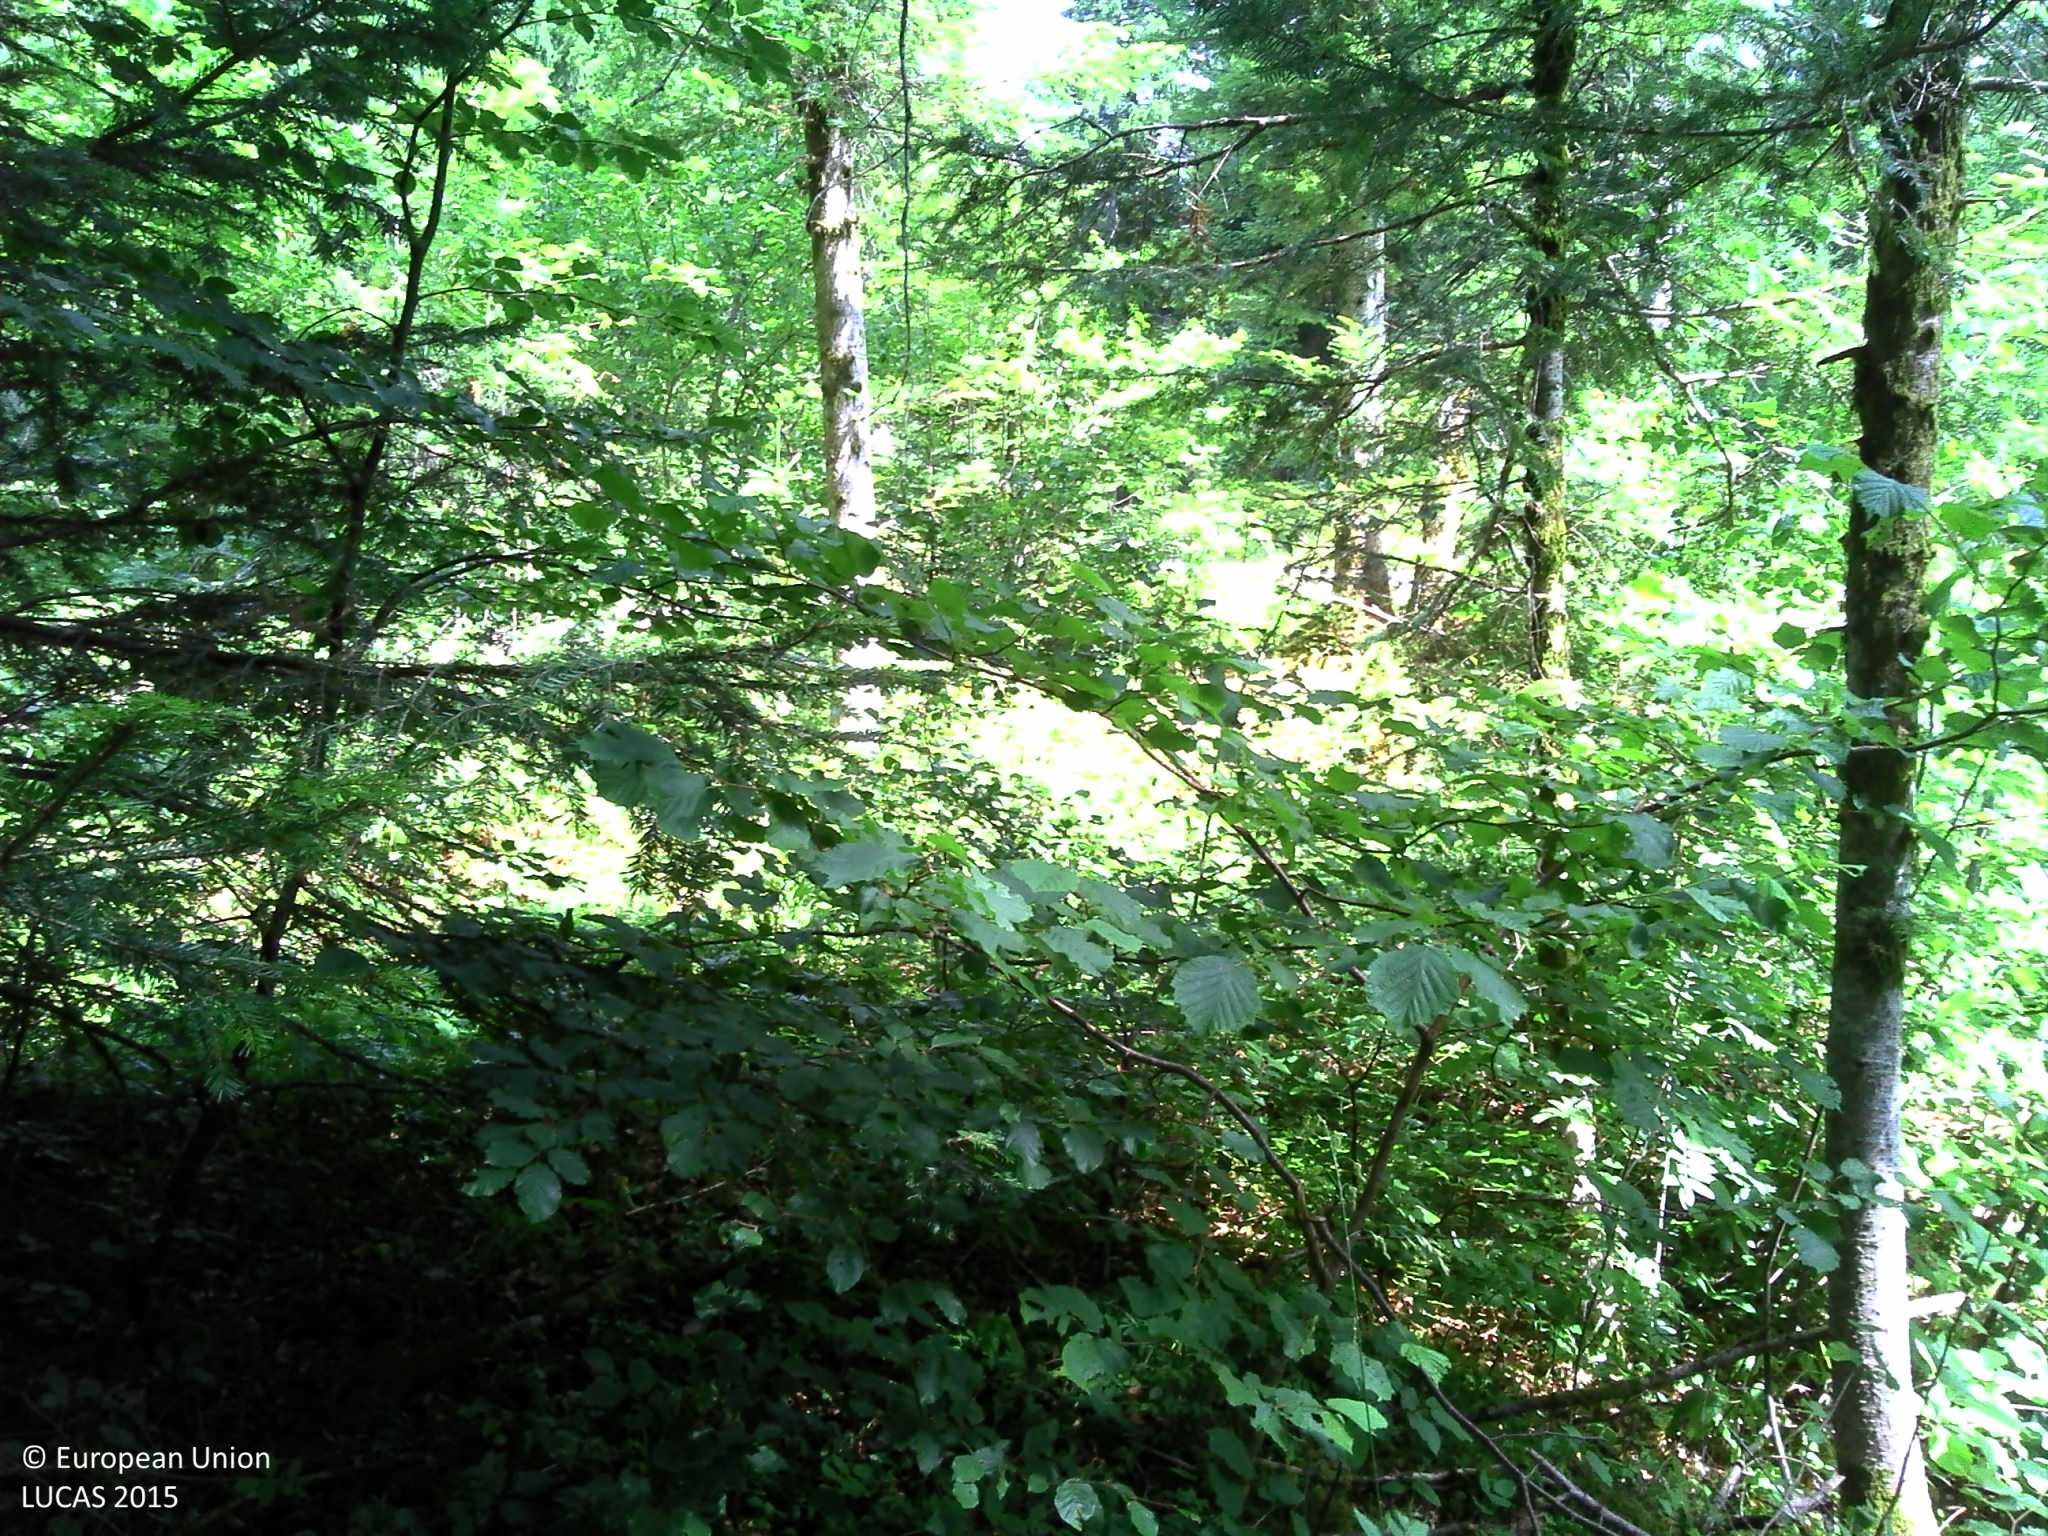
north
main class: Woodland
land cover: Other mixed woodland
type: mountainous beech forest
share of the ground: > 75 %
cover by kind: coniferous forest trees 30 %, broadleaved forest trees 30 %, lichens and mosses 15 %, consolidated bare surface 15 %, herbaceous plants 10 %
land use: Forestry
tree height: > 5 m
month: July
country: FR
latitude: 46.7513
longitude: 6.1670
